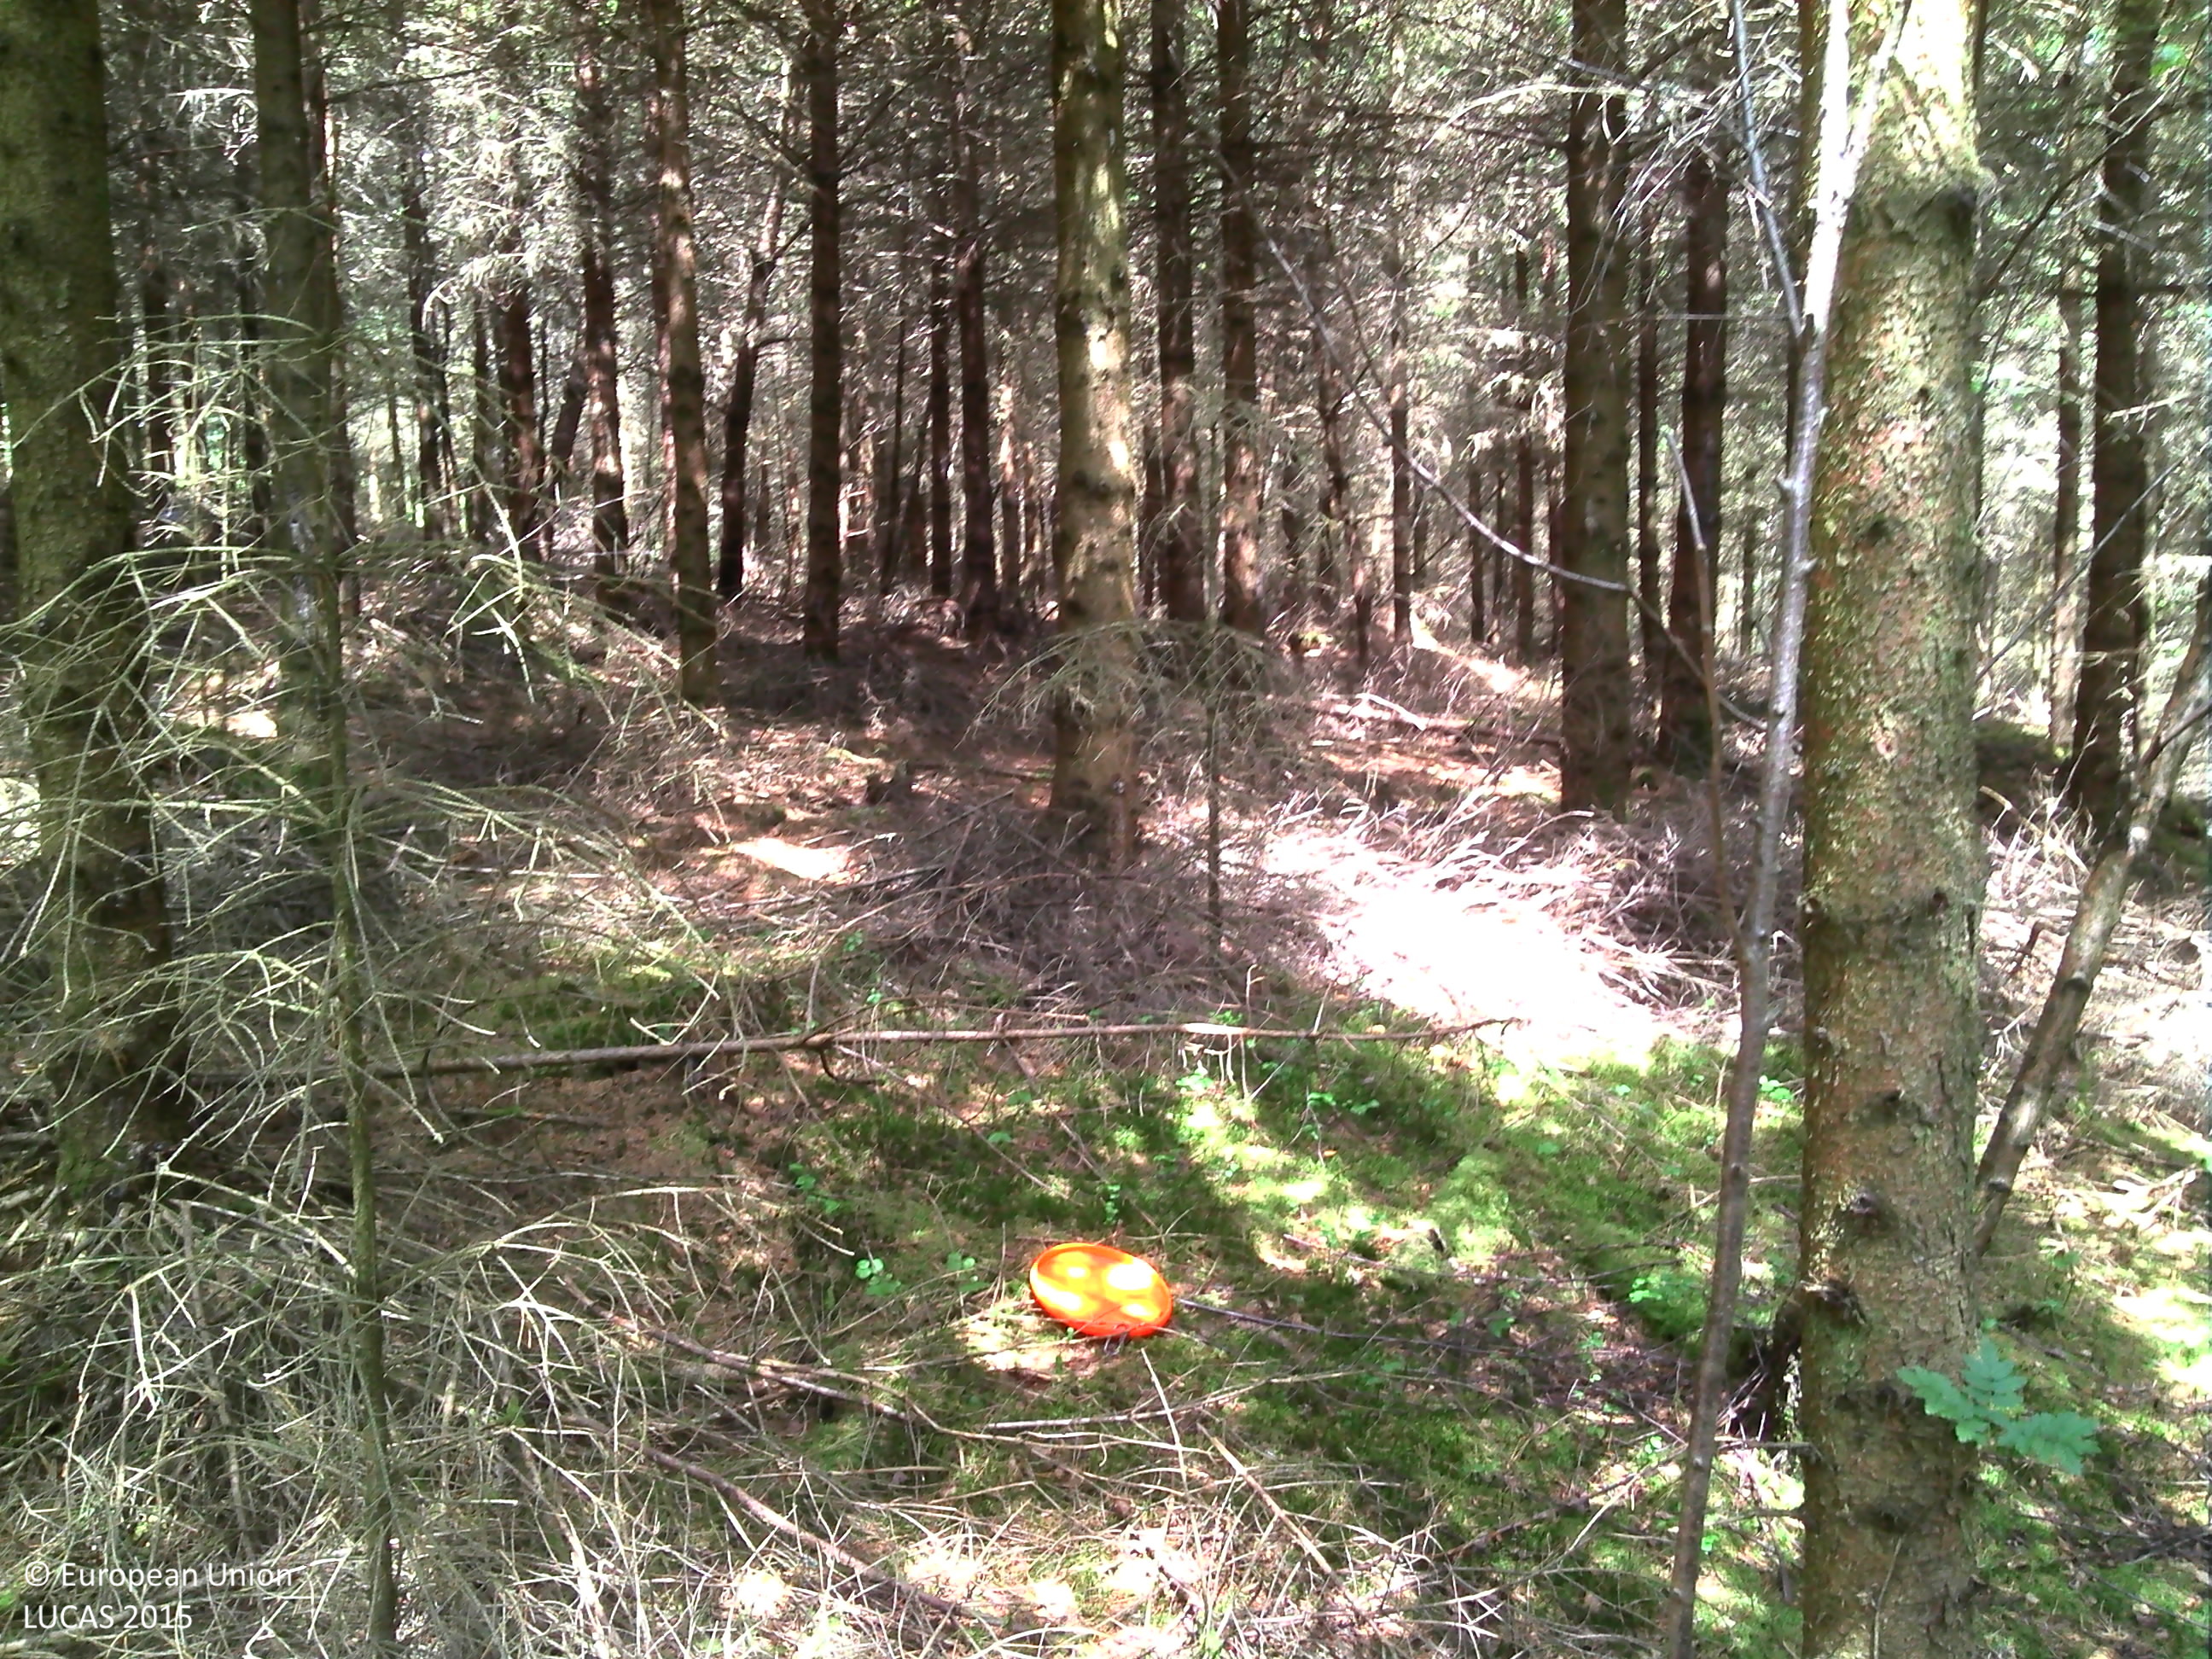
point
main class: Woodland
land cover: Spruce dominated coniferous woodland
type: exotic forest
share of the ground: > 75 %
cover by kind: coniferous forest trees 90 %, lichens and mosses 10 %
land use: Forestry
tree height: > 5 m
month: July
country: BE
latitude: 50.2658
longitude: 6.2256
